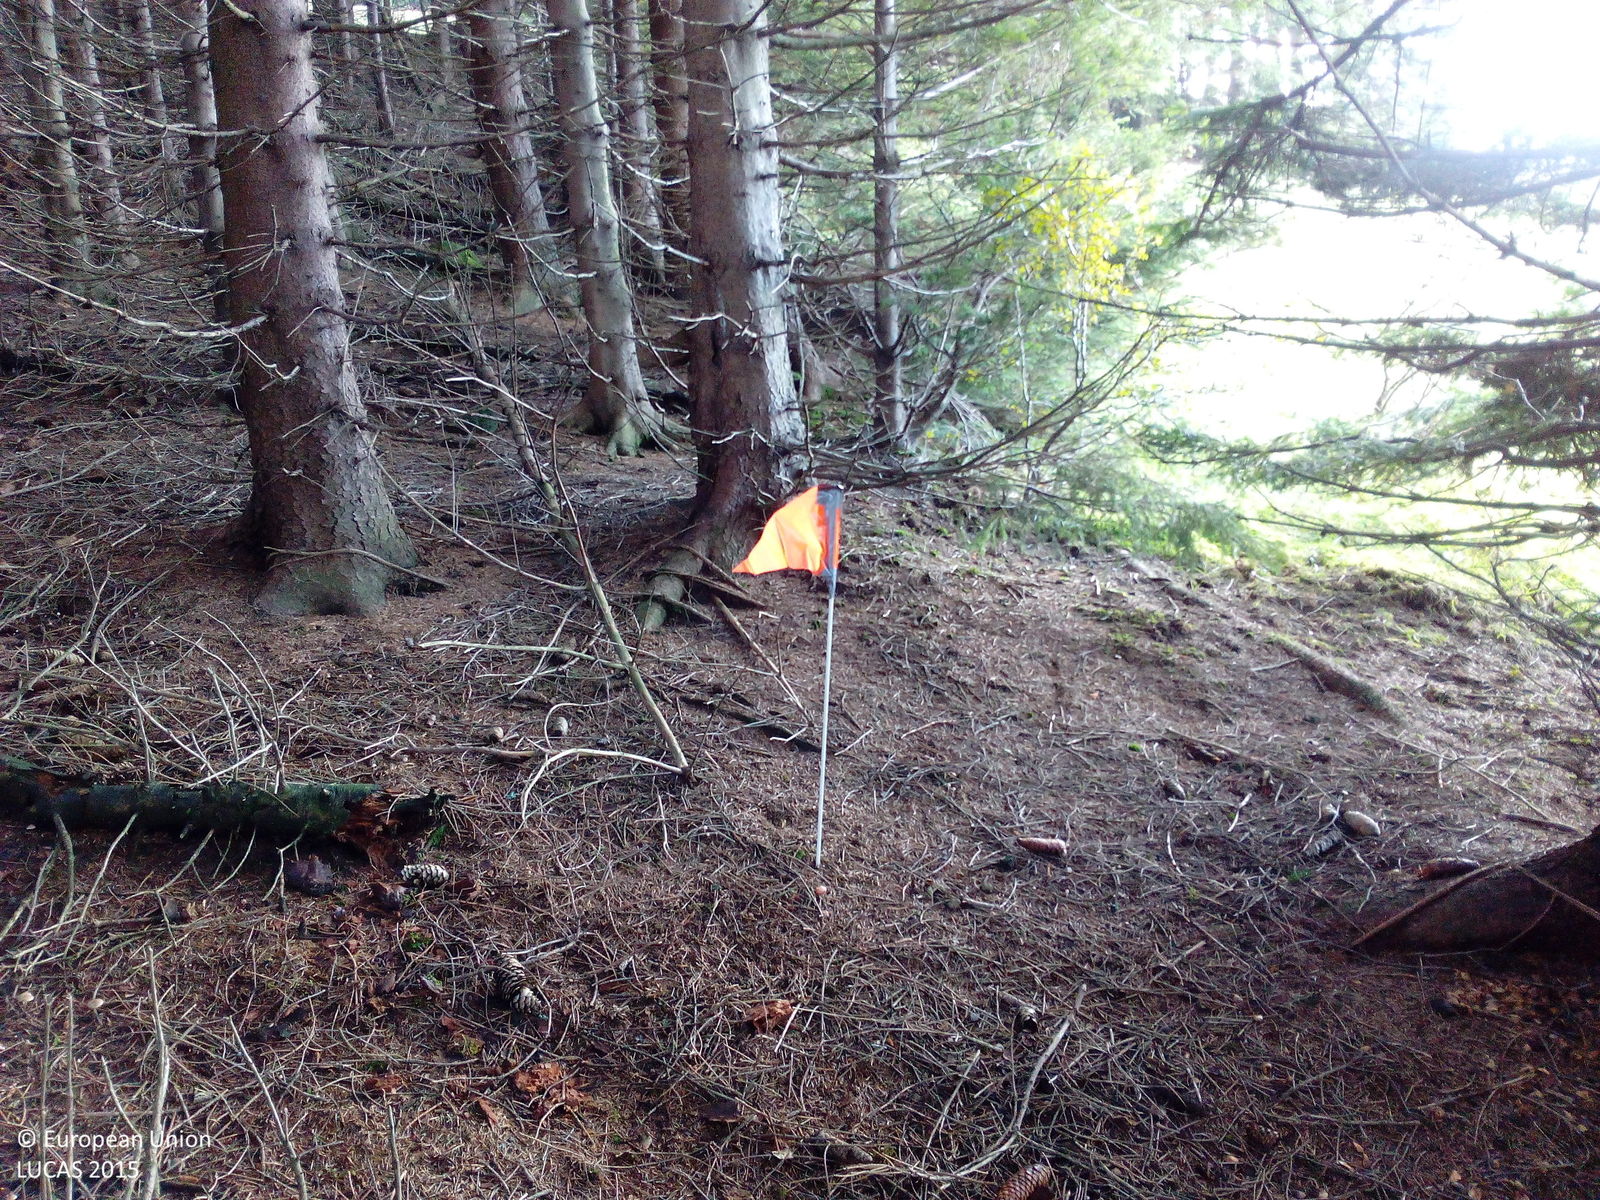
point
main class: Woodland
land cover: Spruce dominated coniferous woodland
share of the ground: > 75 %
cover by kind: coniferous forest trees 80 %, consolidated bare surface 15 %, lichens and mosses 5 %
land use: Forestry
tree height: > 5 m
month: October
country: DE
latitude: 50.4000
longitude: 9.9578
